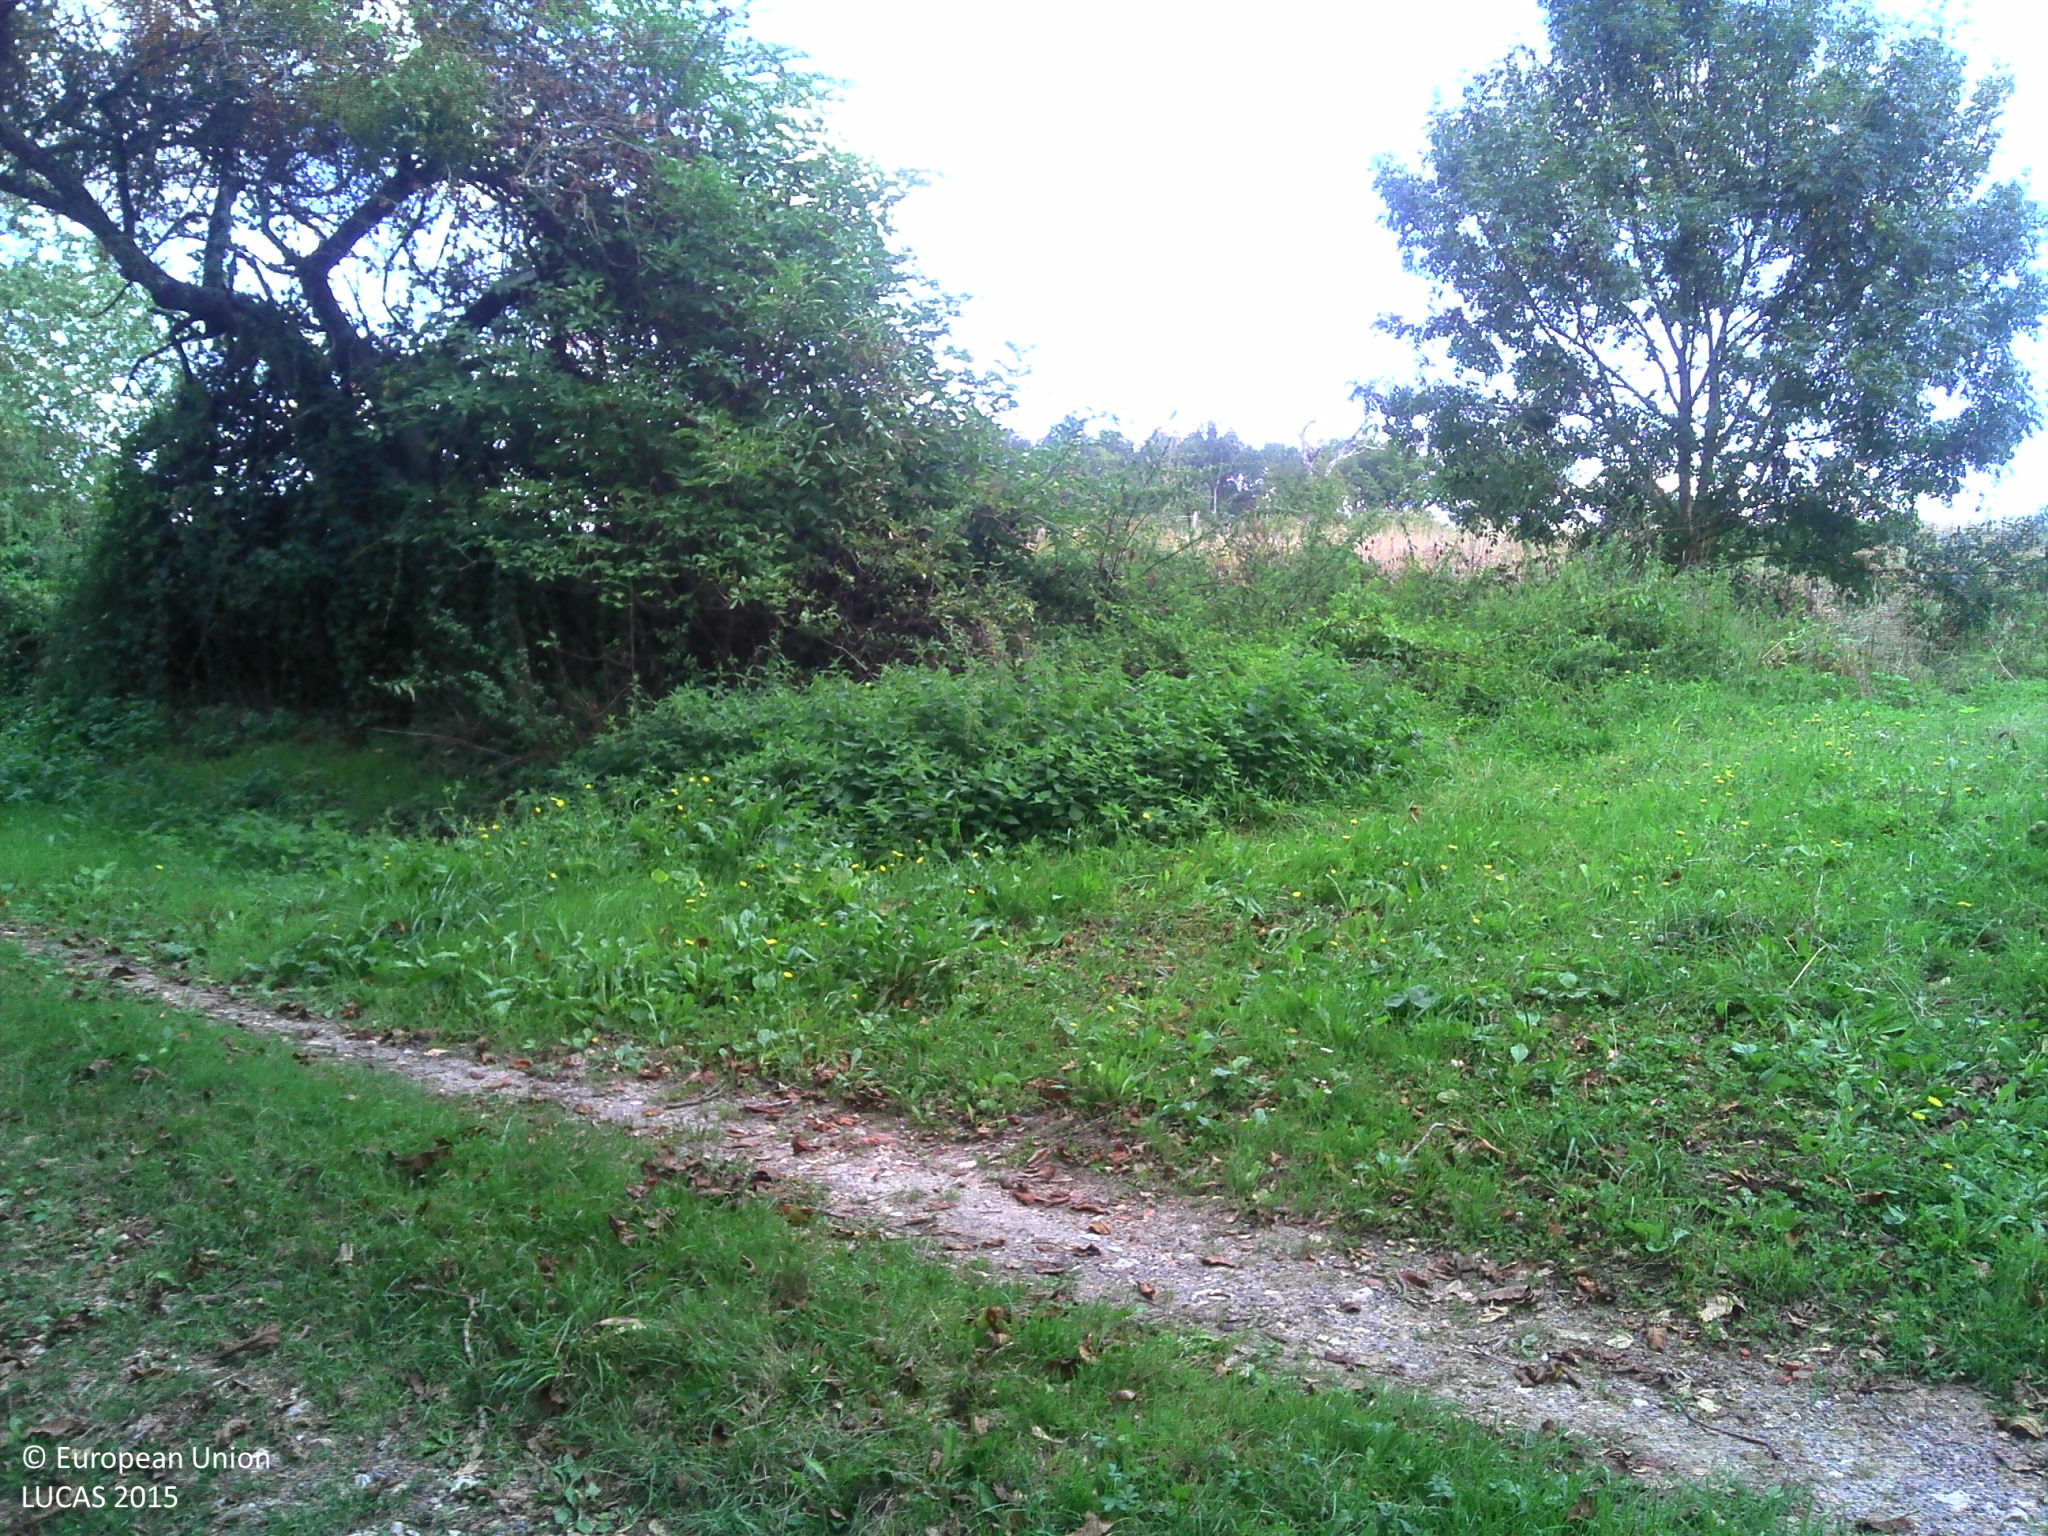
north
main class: Grassland
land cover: Grassland with sparse tree/shrub cover
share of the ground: > 75 %
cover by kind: herbaceous plants 95 %, coniferous forest trees 5 %
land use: Residential
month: September
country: FR
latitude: 46.9843
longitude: 1.4286
